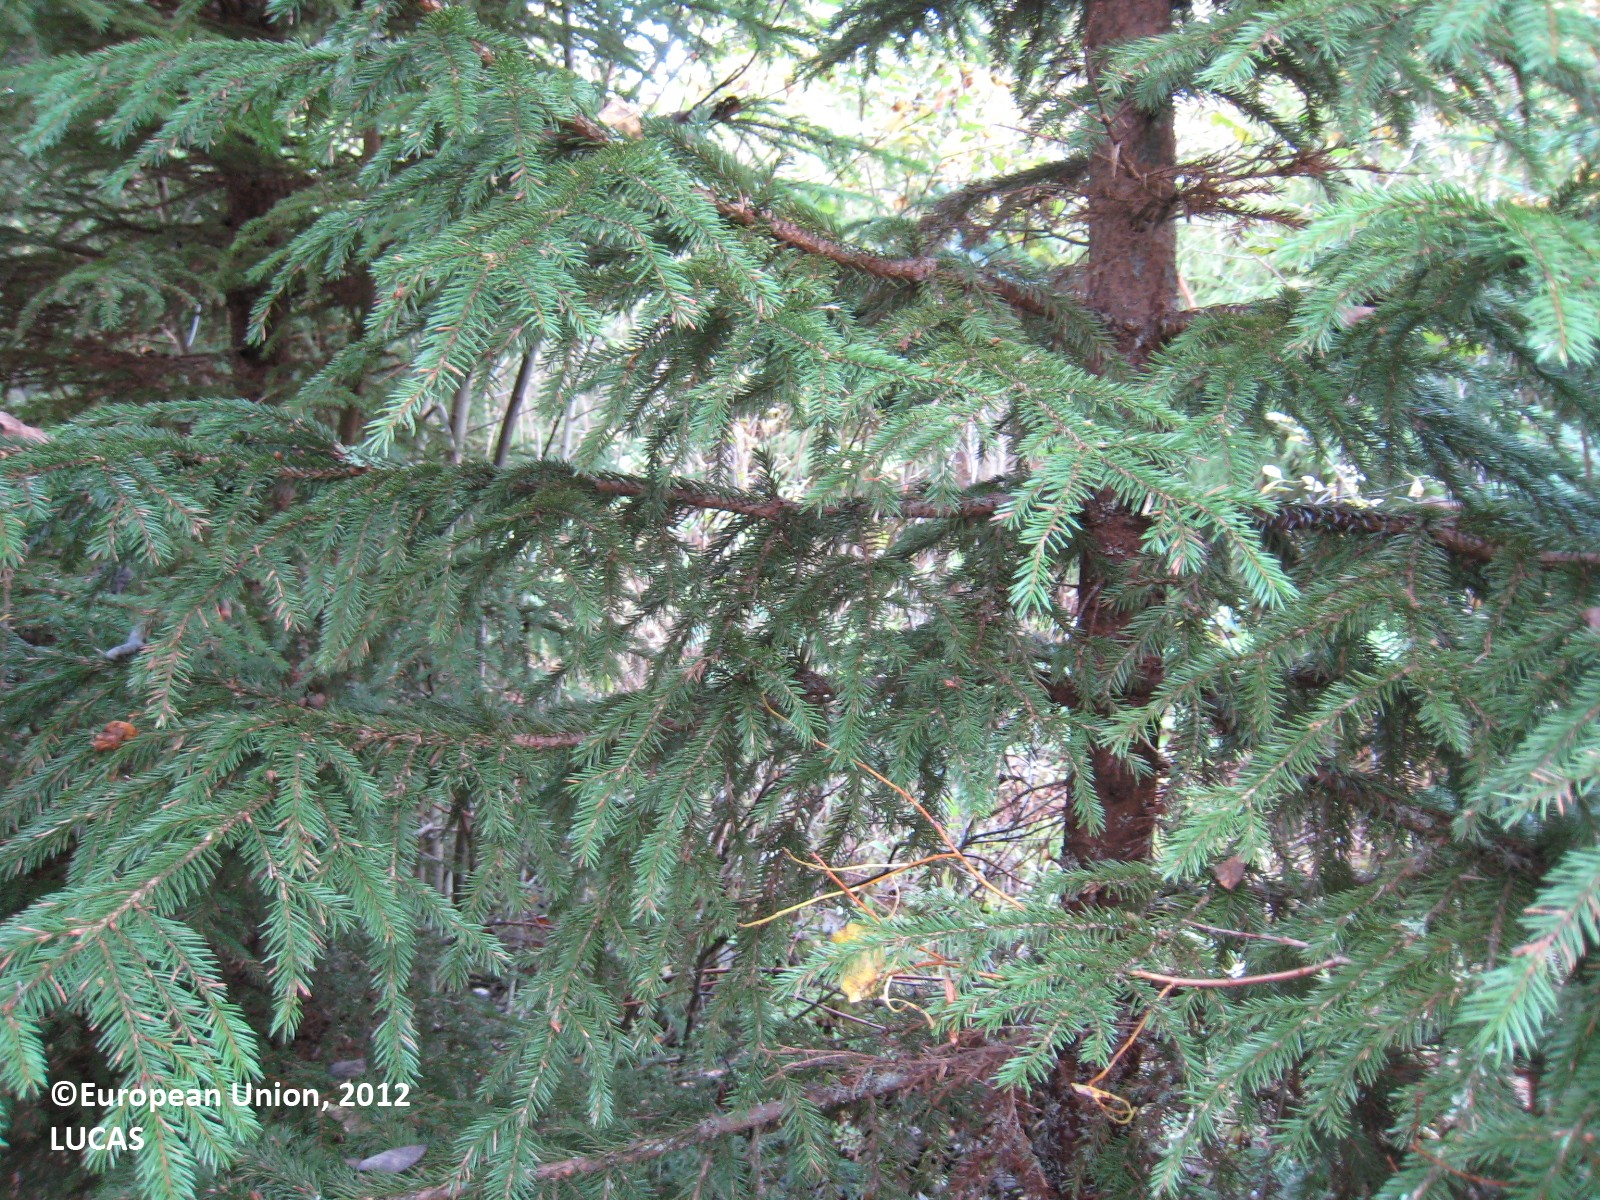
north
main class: Woodland
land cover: Spruce dominated mixed woodland
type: boreal forest
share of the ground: > 75 %
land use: Forestry
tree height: > 5 m
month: September
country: FI
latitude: 62.6409
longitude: 26.6208
